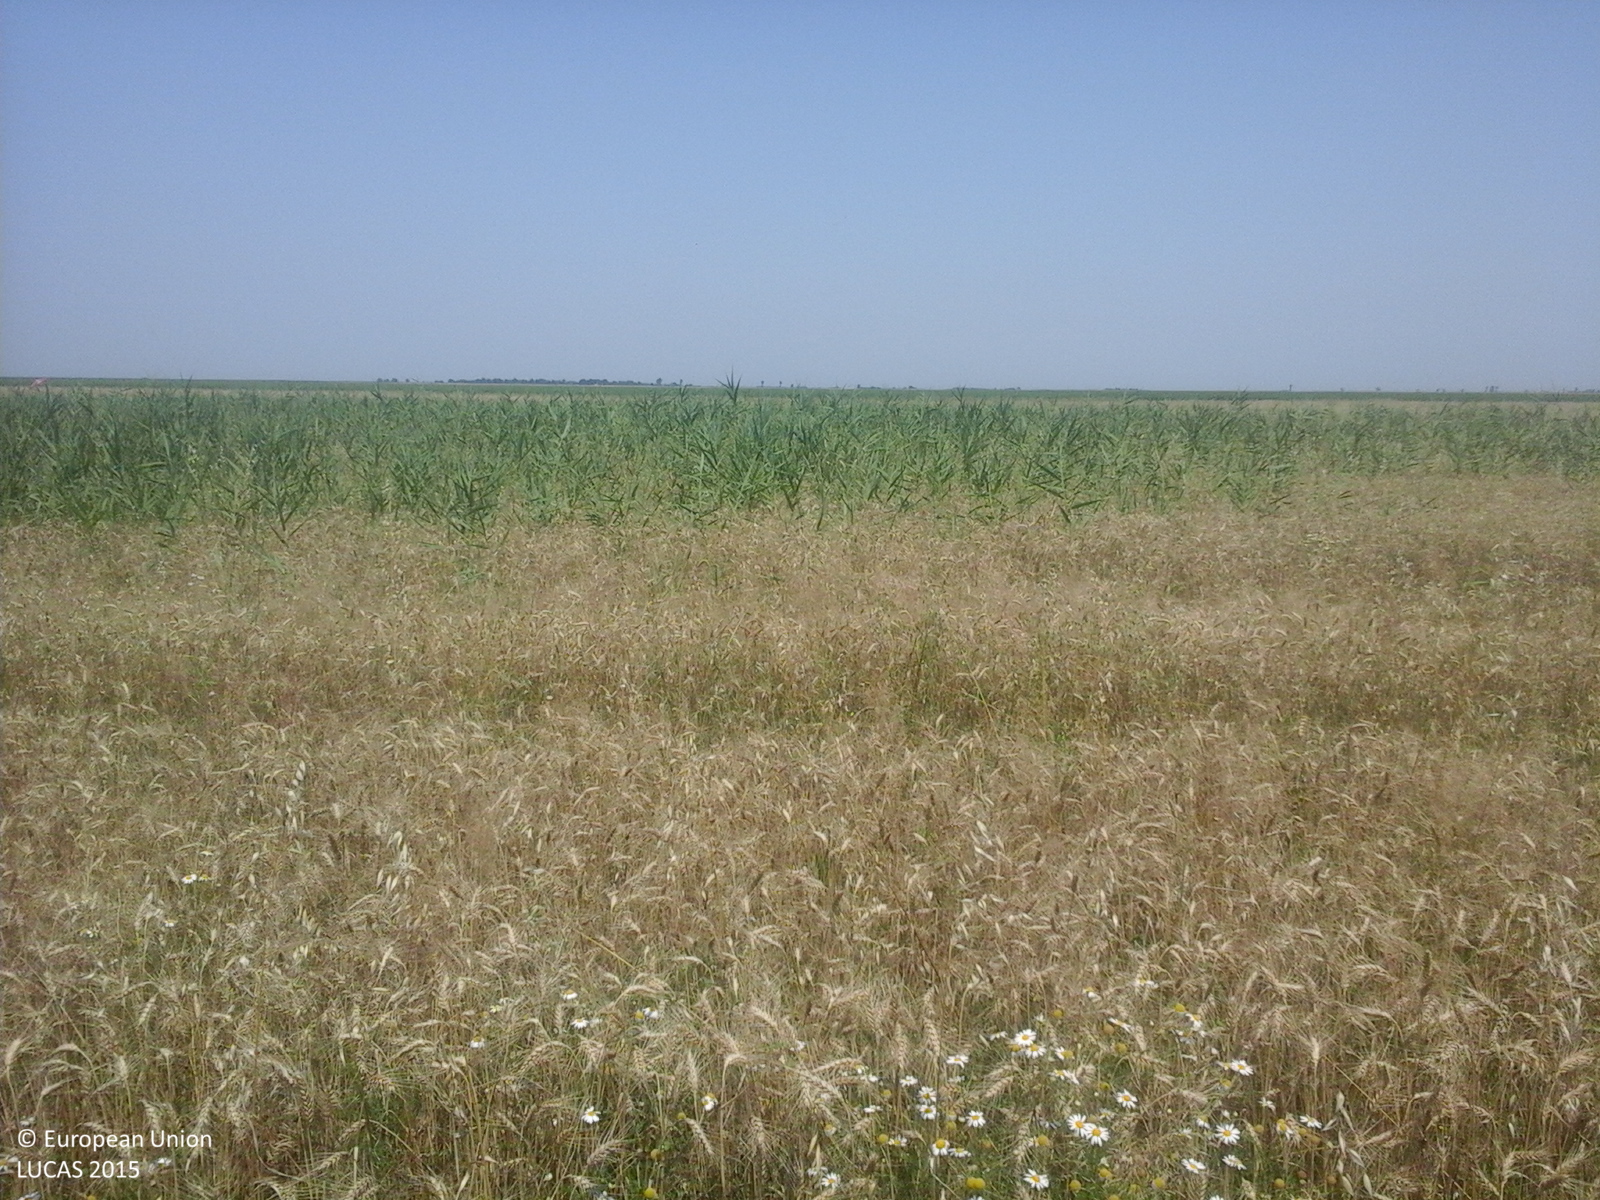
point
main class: Cropland
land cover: Mixed cereals for fodder
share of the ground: > 75 %
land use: Agriculture (excluding fallow land and kitchen gardens)
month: July
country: RO
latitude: 44.4587
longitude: 24.8963
